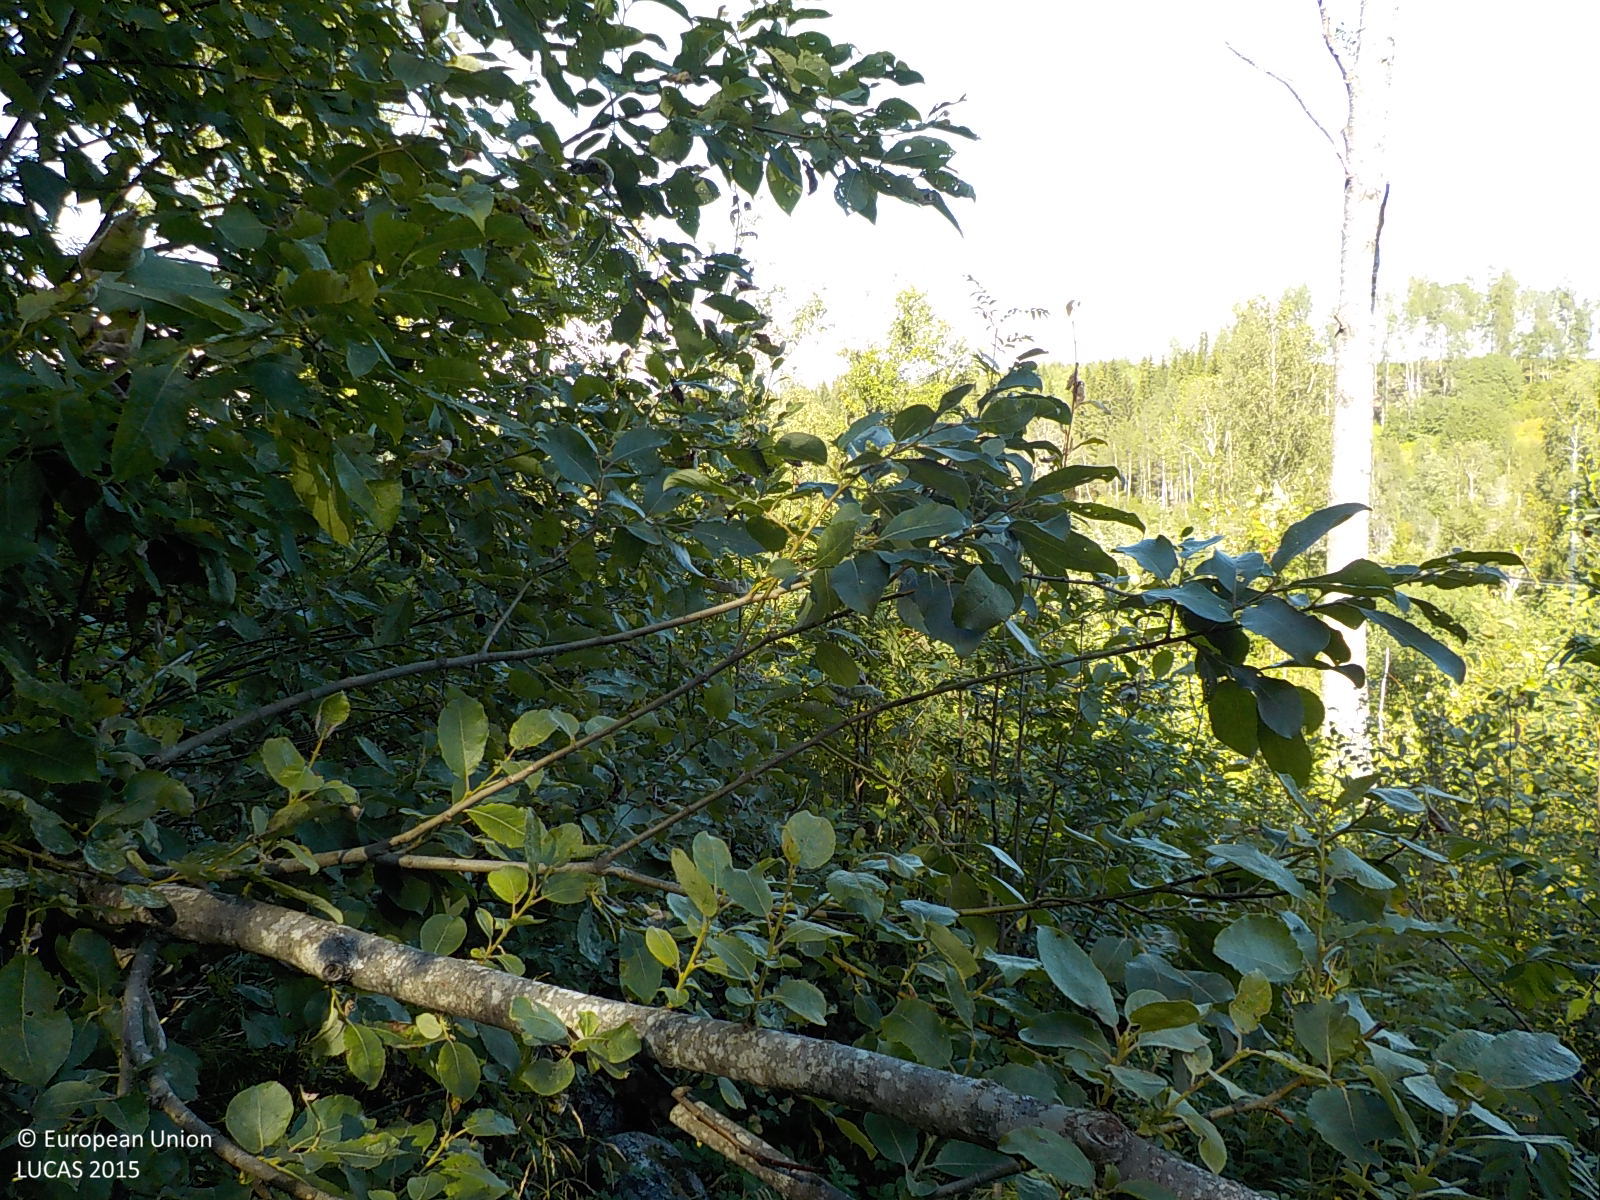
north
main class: Woodland
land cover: Broadleaved woodland
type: hemiboreal forest and nemoral coniferous forest and mixed broadleaved-coniferous forest
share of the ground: > 75 %
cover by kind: broadleaved forest trees 85 %, herbaceous plants 15 %
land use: Forestry
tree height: < 5 m
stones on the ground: 10 - 25 %
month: August
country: SE
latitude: 63.3318
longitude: 18.8654
